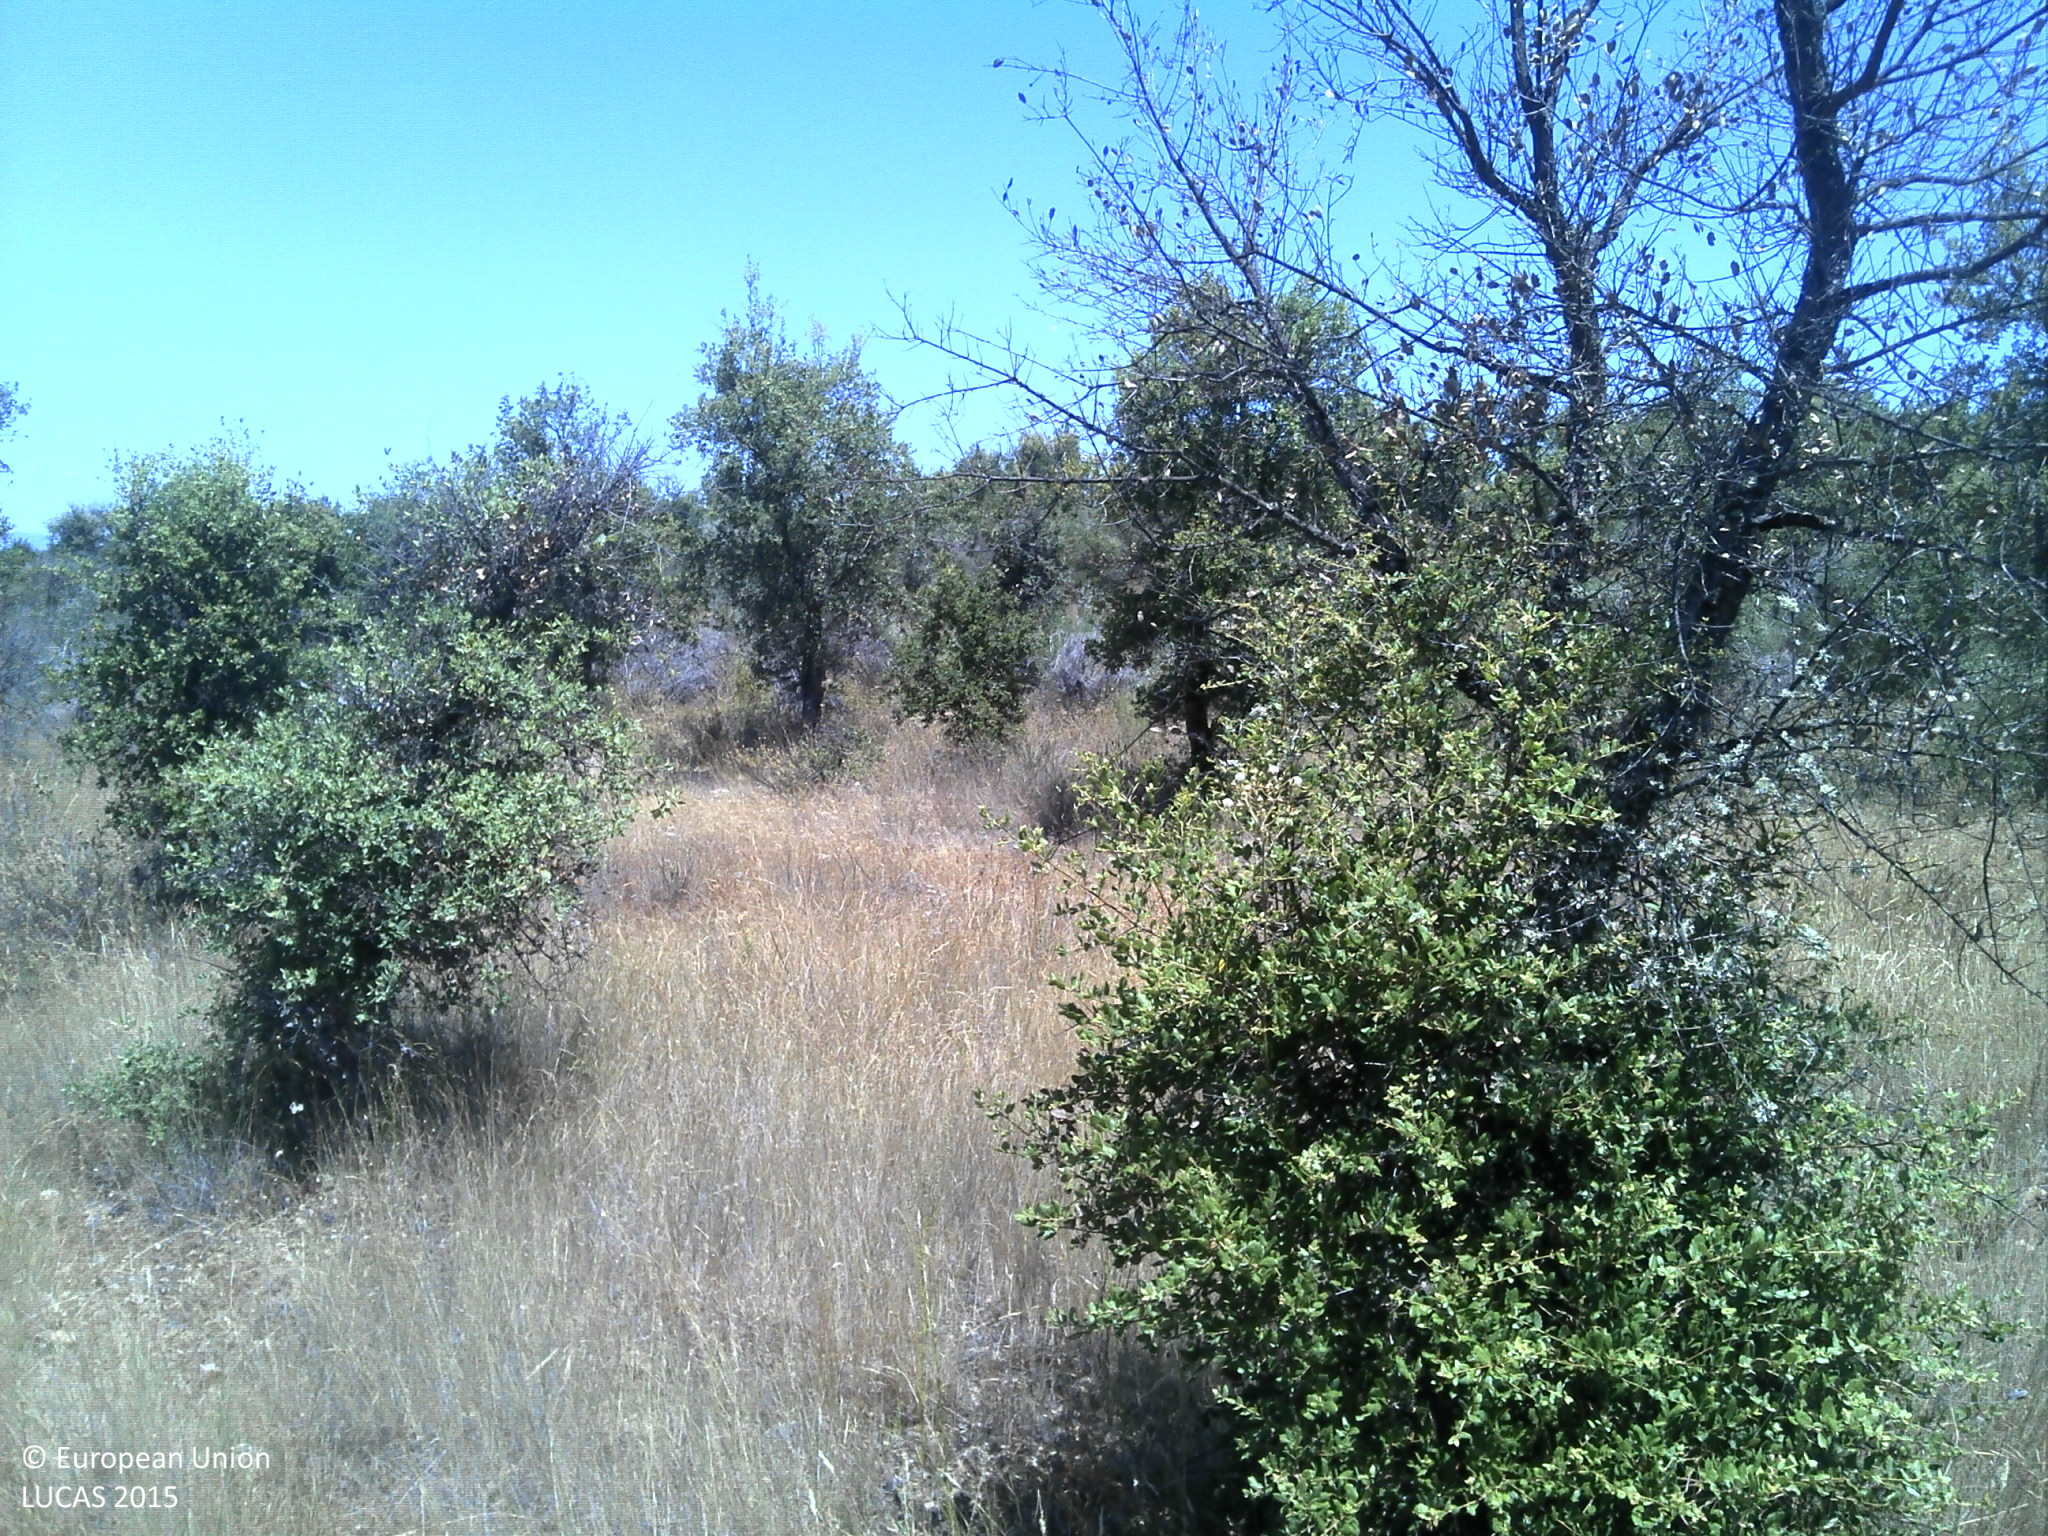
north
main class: Woodland
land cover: Broadleaved woodland
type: broadleaved evergreen forest
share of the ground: 25 - 50 %
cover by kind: broadleaved forest trees 45 %, herbaceous plants 20 %, unconsolidated bare surface 20 %, shrubs 15 %
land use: Forestry
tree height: < 5 m
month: June
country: PT
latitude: 40.0903
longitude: -7.2572
